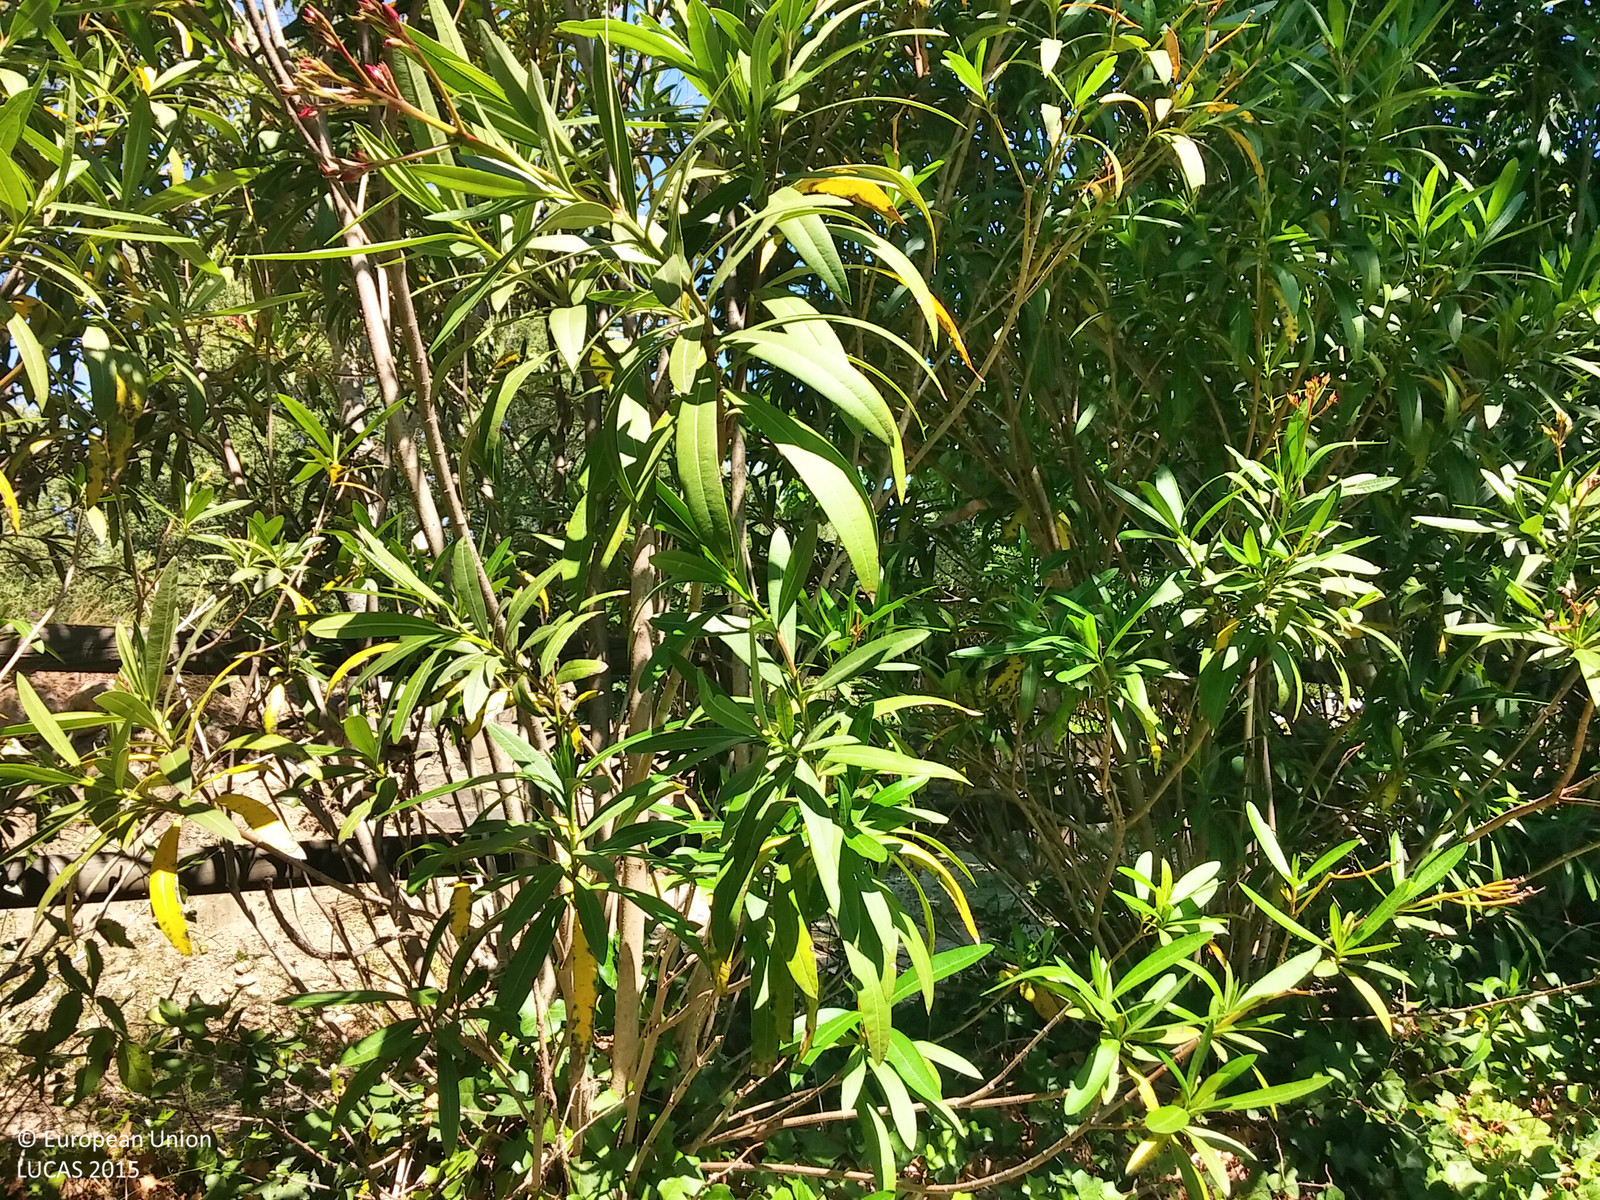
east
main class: Woodland
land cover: Broadleaved woodland
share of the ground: 50 - 75 %
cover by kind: broadleaved forest trees 65 %, shrubs 30 %
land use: Semi-natural and natural areas not in use
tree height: > 5 m
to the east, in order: Broadleaved woodland; Fences; Tracks; Broadleaved woodland; Grass margins; Paved roads, cycling and walking lanes; Grass margins; Broadleaved woodland; Dry stone walls; Broadleaved woodland; Tracks; Vineyards; Broadleaved woodland
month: May
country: ES
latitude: 42.3775
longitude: 3.0305
